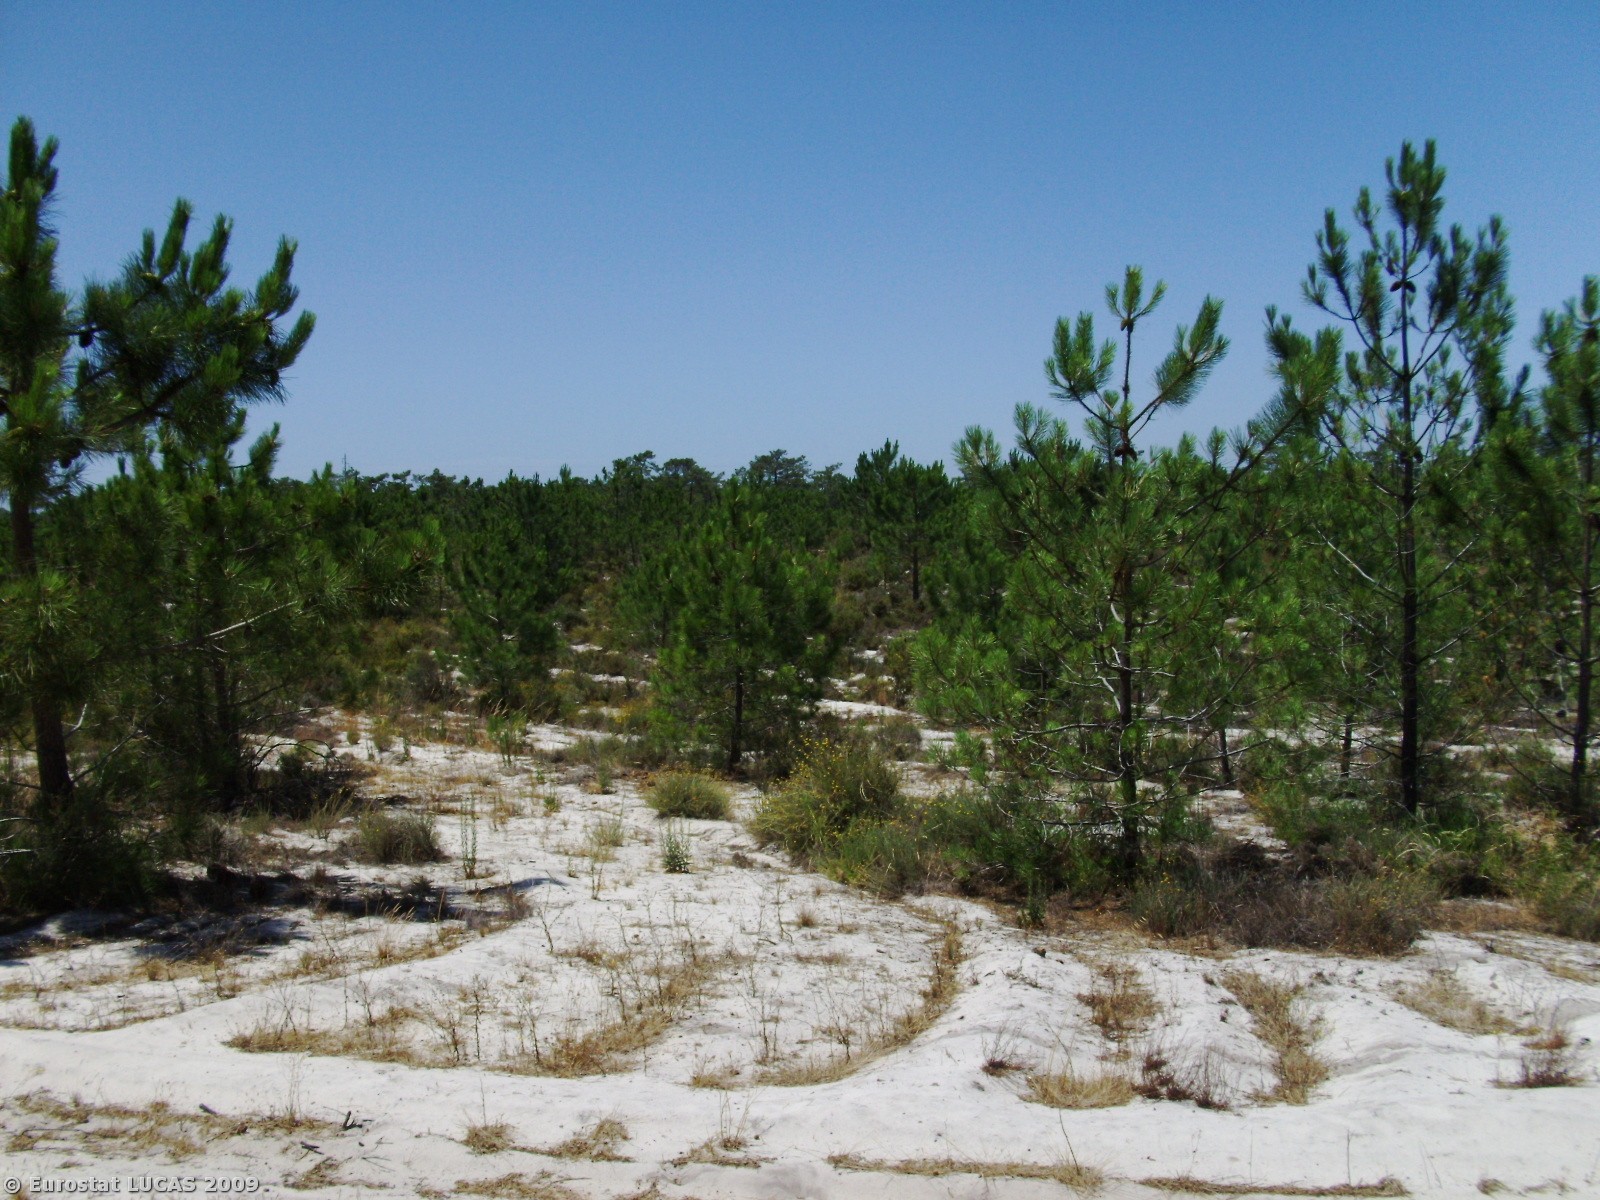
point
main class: Woodland
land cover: Coniferous woodland
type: coniferous forest of the mediterranean region
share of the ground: 25 - 50 %
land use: Forestry
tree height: > 5 m
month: June
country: PT
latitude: 38.3807
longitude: -8.7747
